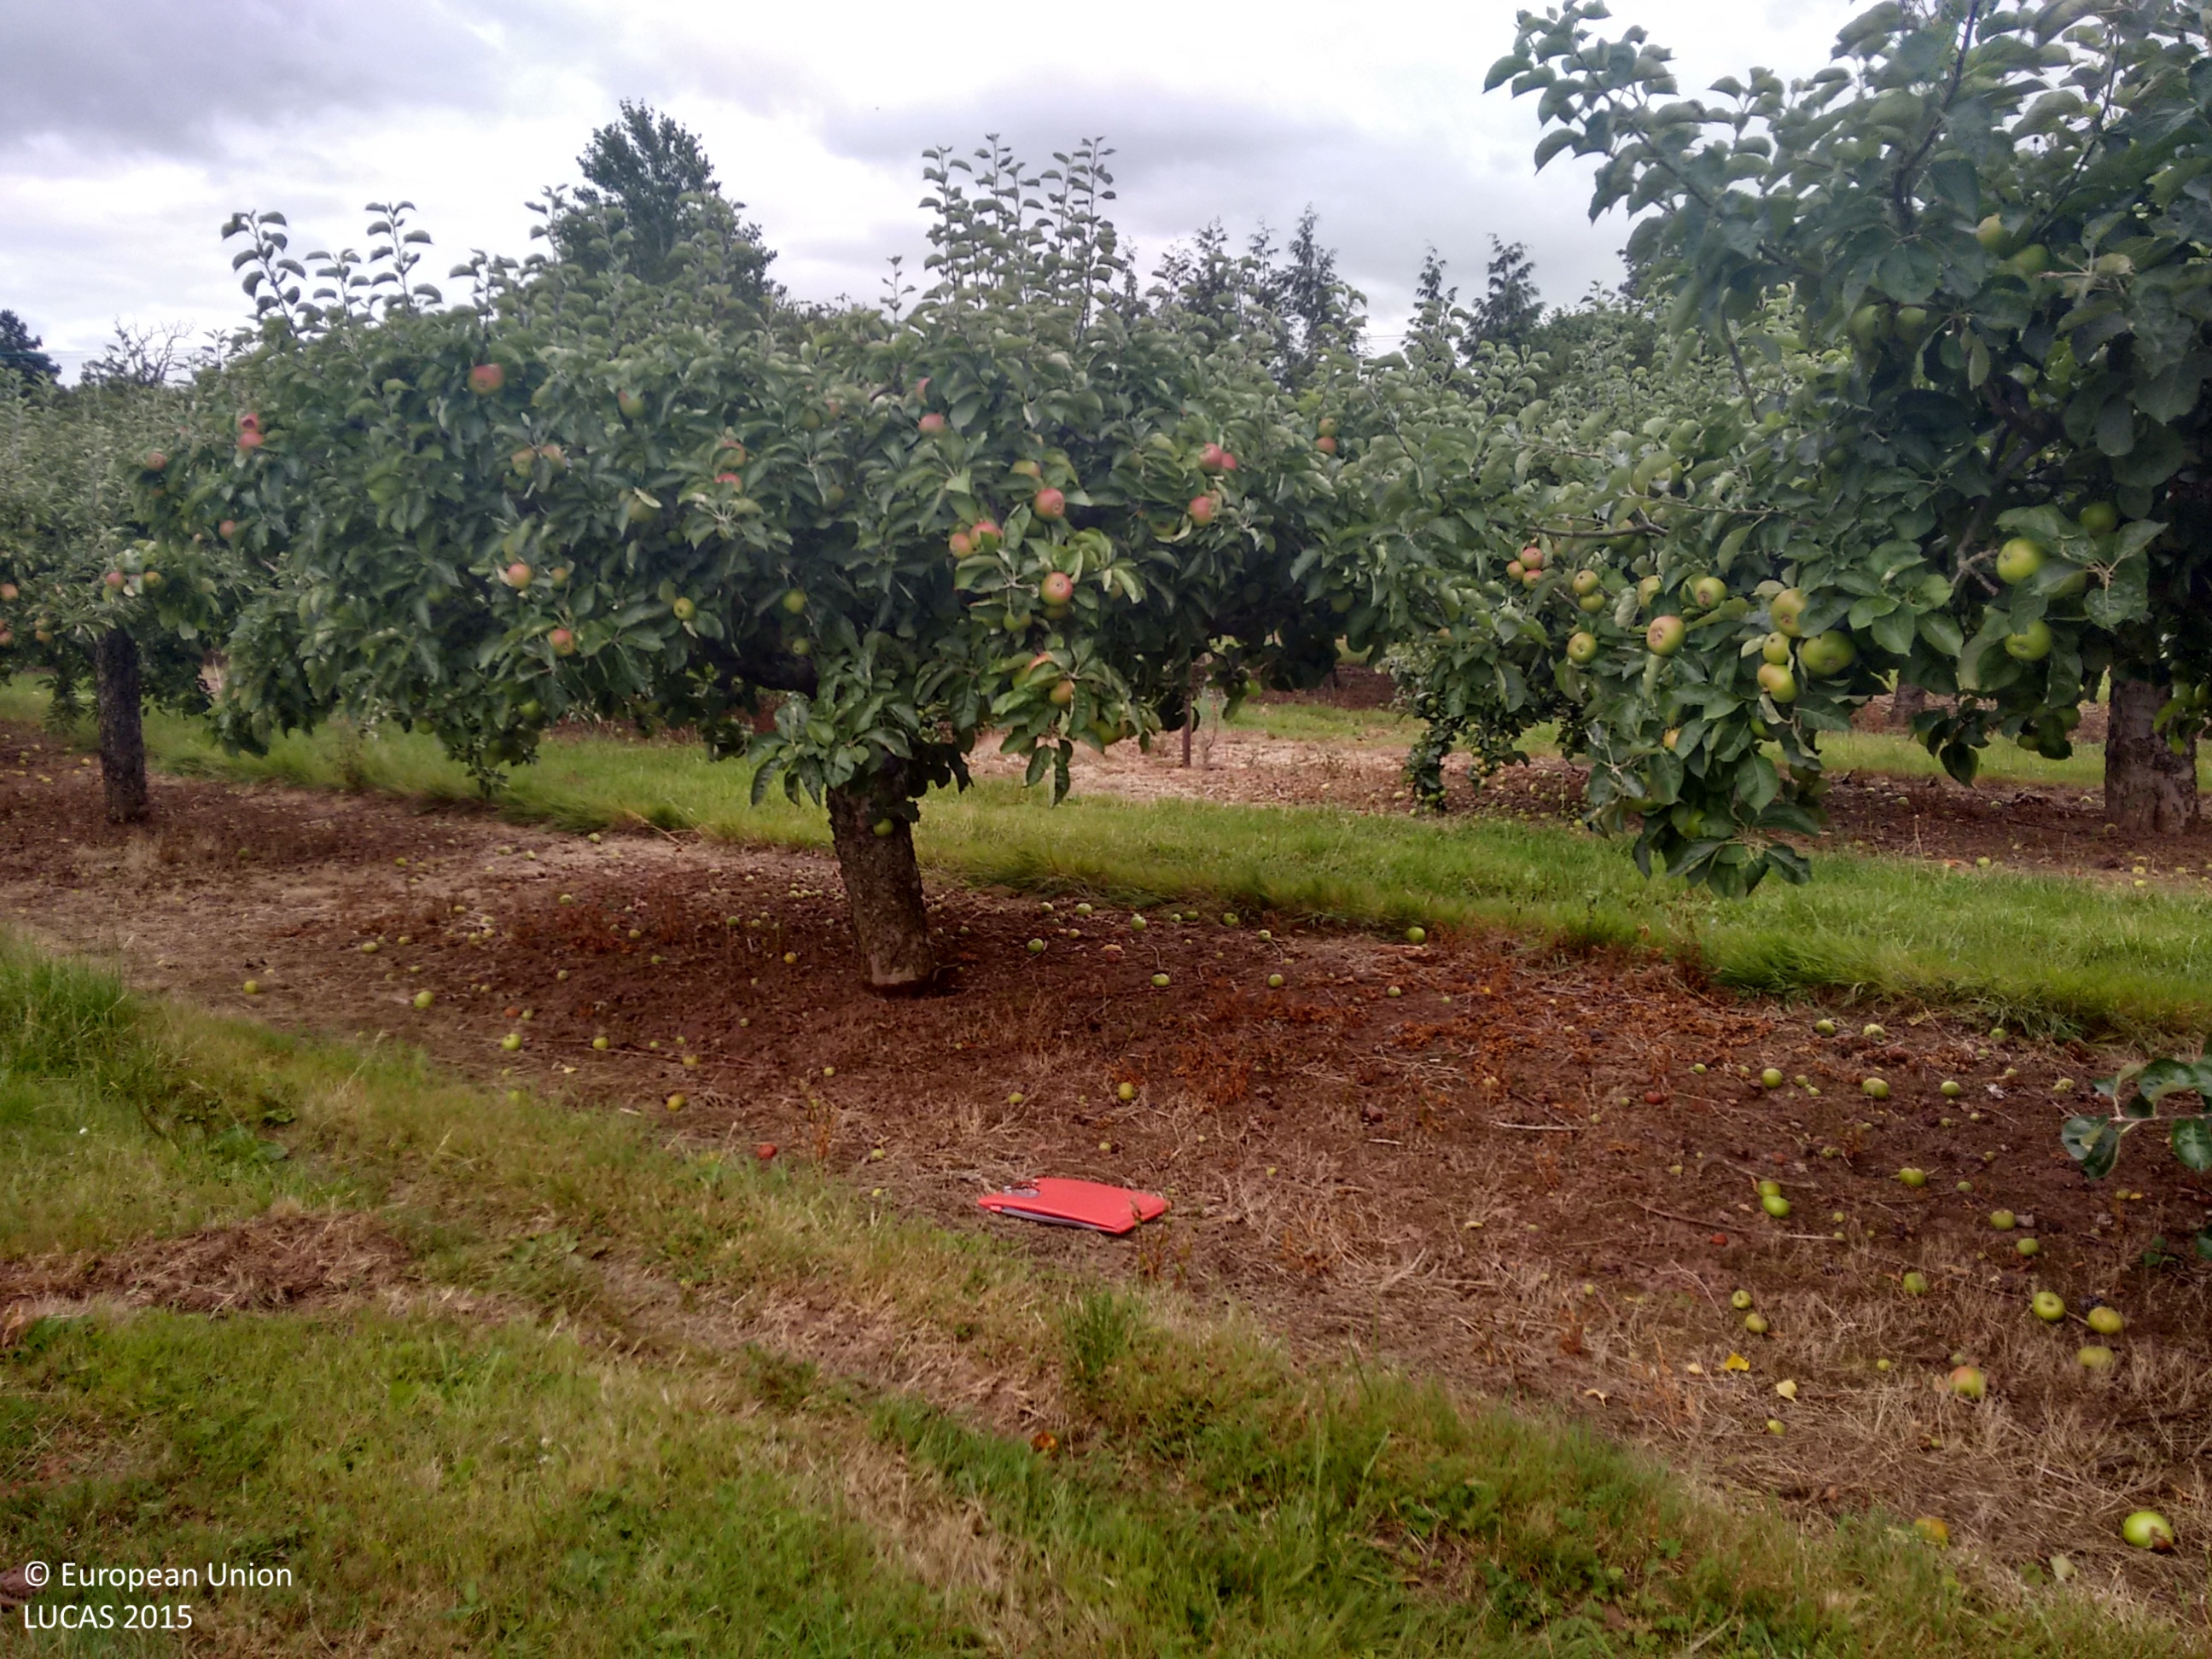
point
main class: Cropland
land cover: Apple fruit
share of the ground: > 75 %
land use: Agriculture (excluding fallow land and kitchen gardens)
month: August
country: GB
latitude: 51.9631
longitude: -2.7174
